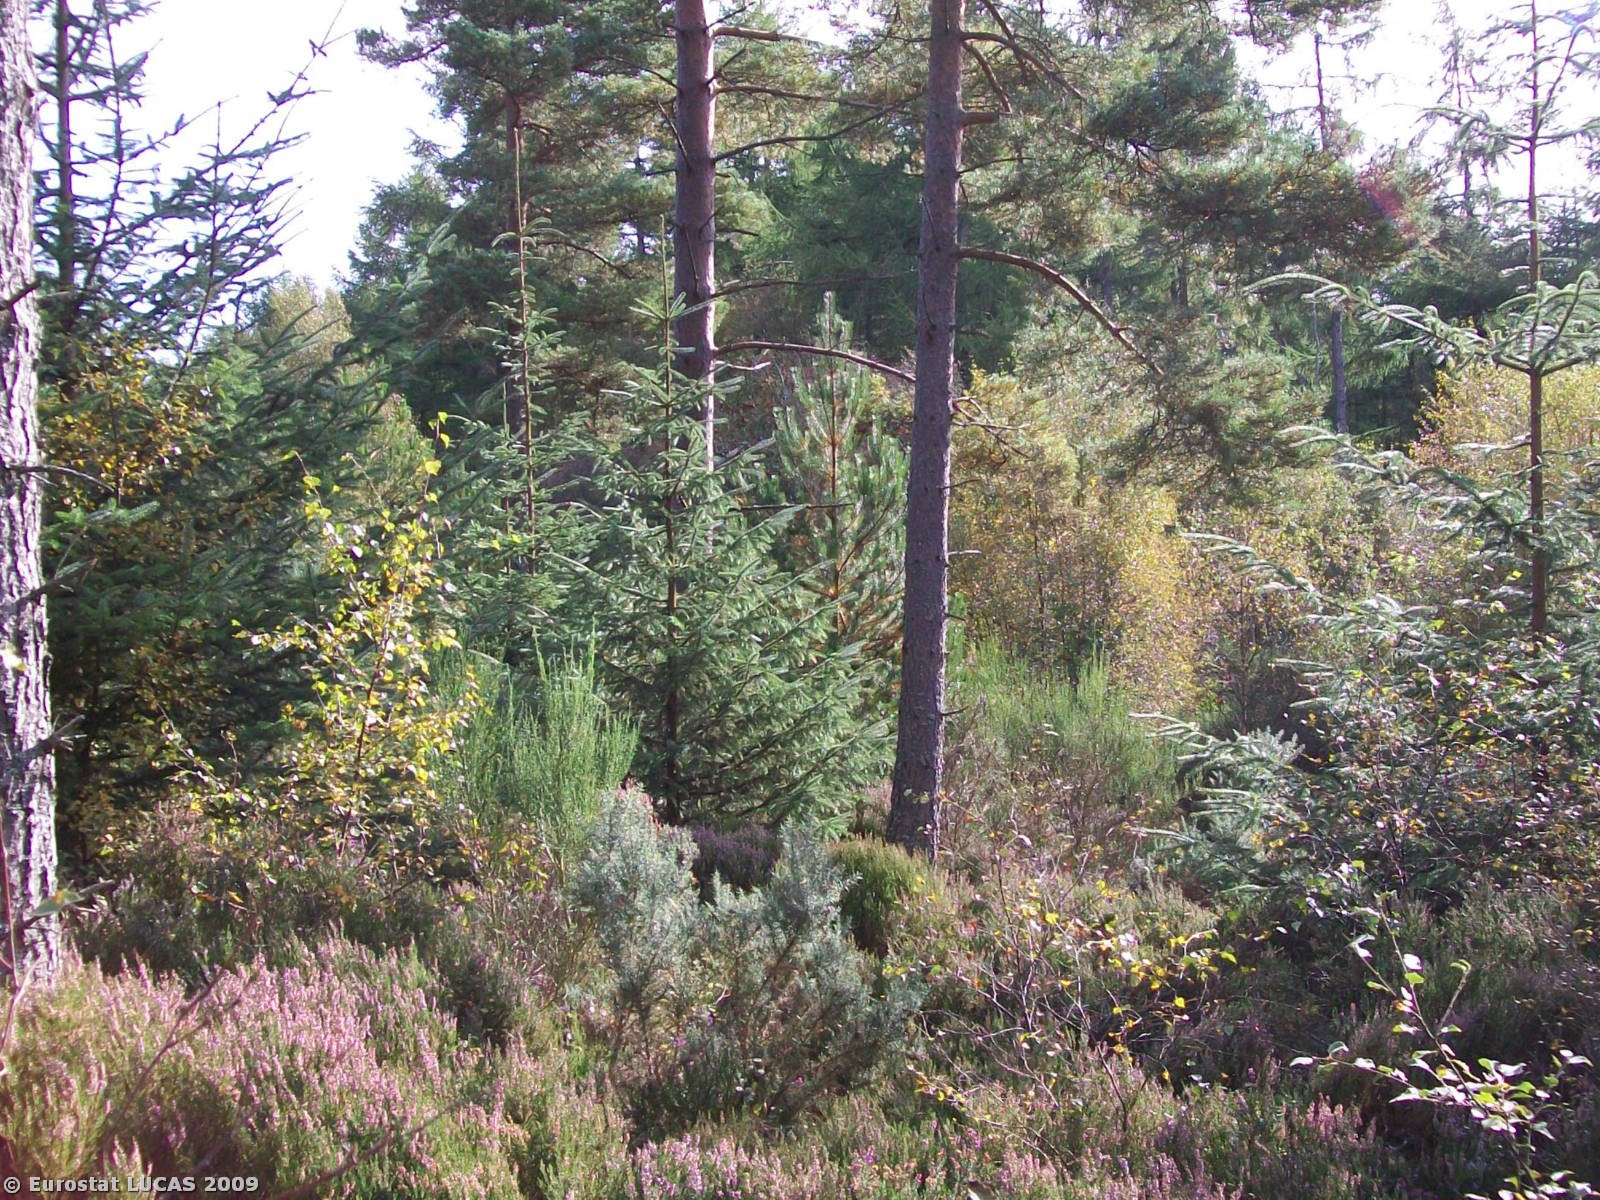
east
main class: Woodland
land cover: Coniferous woodland
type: plantations and self-sown exotic forest
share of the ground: 50 - 75 %
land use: Forestry
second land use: Forestry
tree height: > 5 m
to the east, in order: Coniferous woodland; Shrubland without tree cover; Broadleaved woodland; Ditches and canals; Grass margins; Tracks; Grass margins; Broadleaved woodland; Coniferous woodland; Grass margins; Tracks; Ditches and canals; Grass margins; Coniferous woodland; Grassland with sparse tree/shrub cover; Coniferous woodland; Ditches and canals; Coniferous woodland
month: September
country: GB
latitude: 57.2854
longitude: -2.5130
